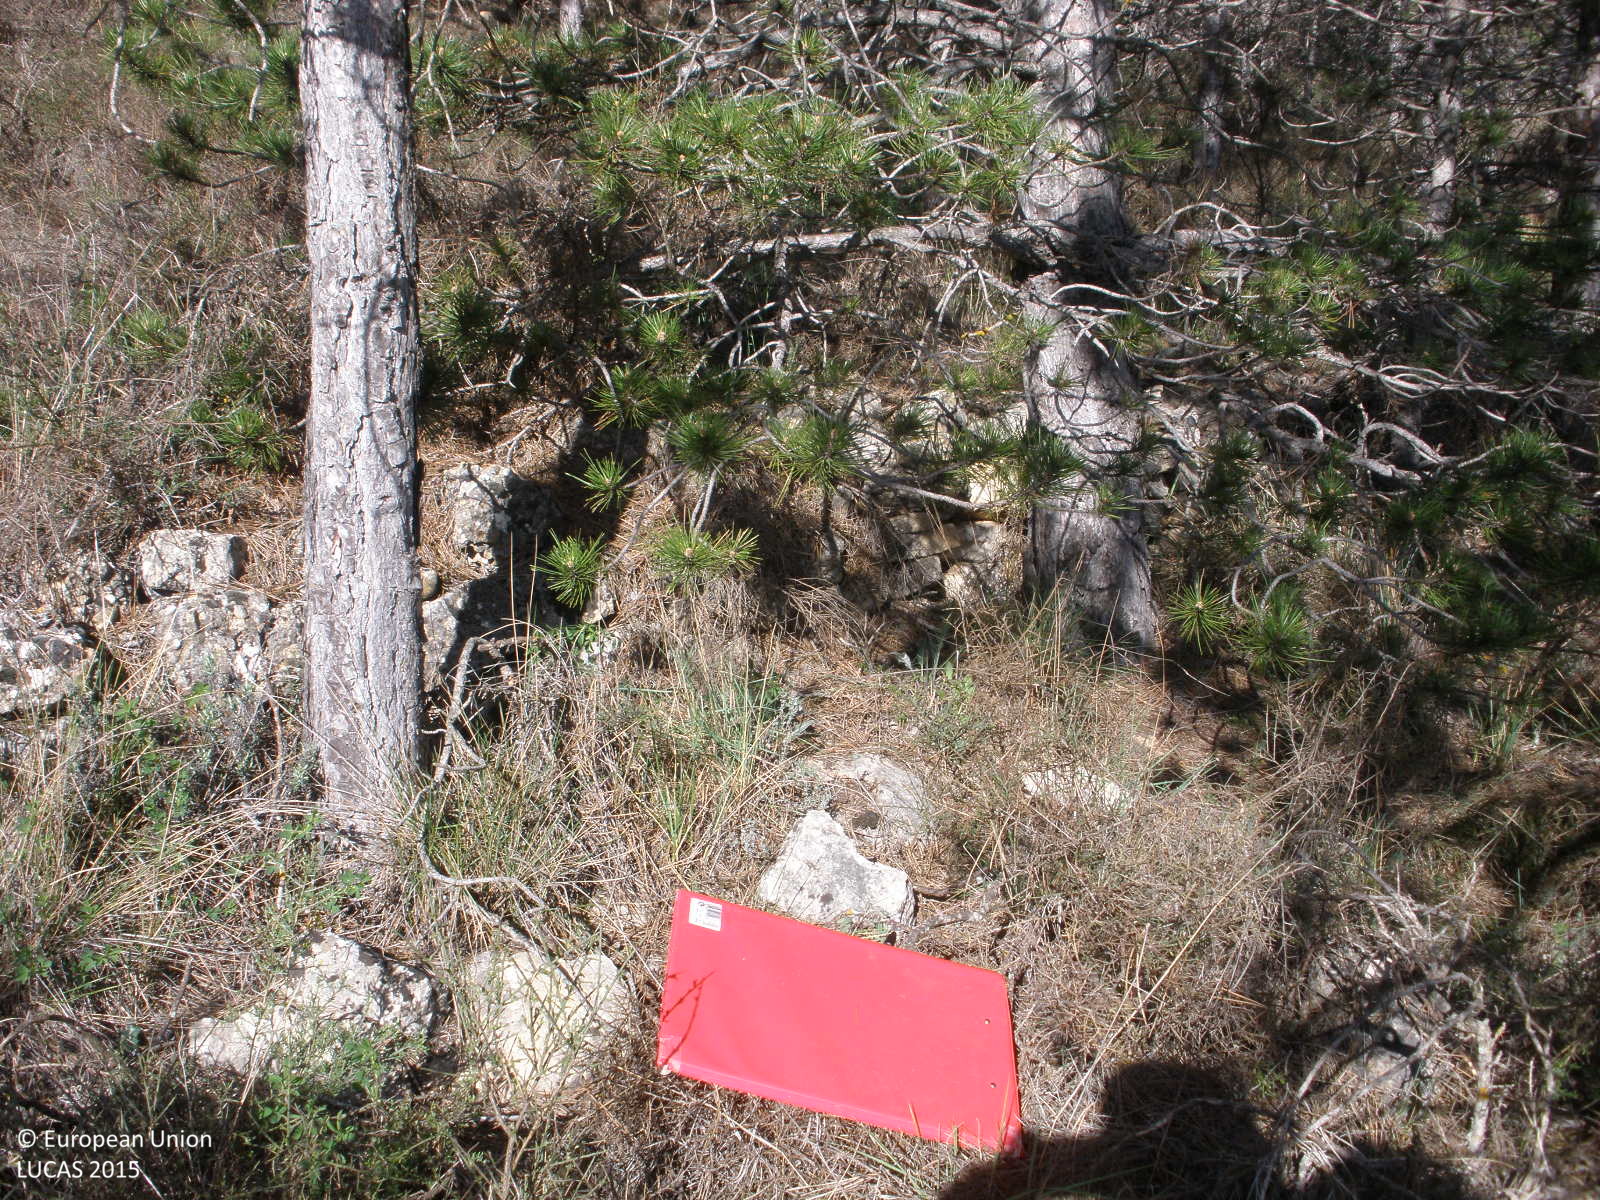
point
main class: Woodland
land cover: Pine dominated coniferous woodland
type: coniferous forest of the mediterranean region
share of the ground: 25 - 50 %
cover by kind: coniferous forest trees 40 %, shrubs 40 %, herbaceous plants 20 %
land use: Semi-natural and natural areas not in use
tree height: > 5 m
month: April
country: ES
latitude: 40.0819
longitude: -1.1845
